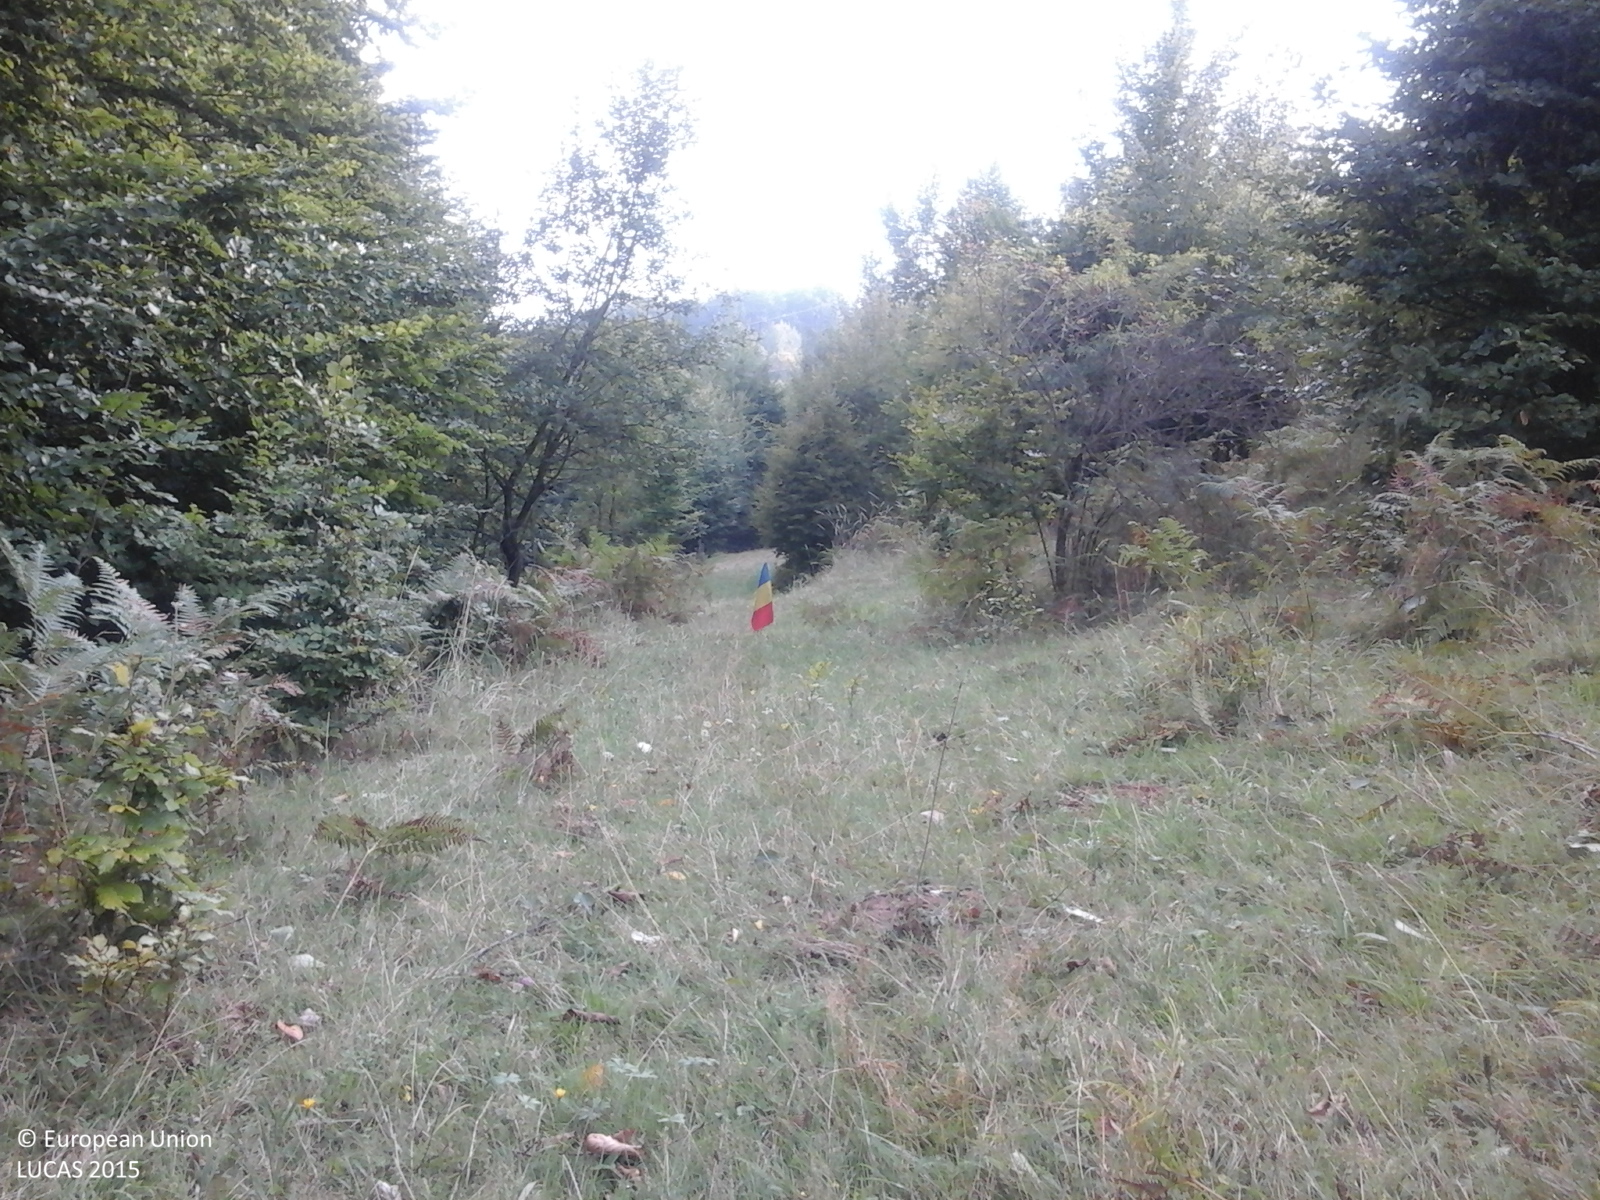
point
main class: Woodland
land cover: Broadleaved woodland
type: mesophytic deciduous forest
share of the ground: > 75 %
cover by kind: broadleaved forest trees 100 %
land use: Forestry
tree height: > 5 m
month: September
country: RO
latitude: 46.9089
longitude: 22.6466
